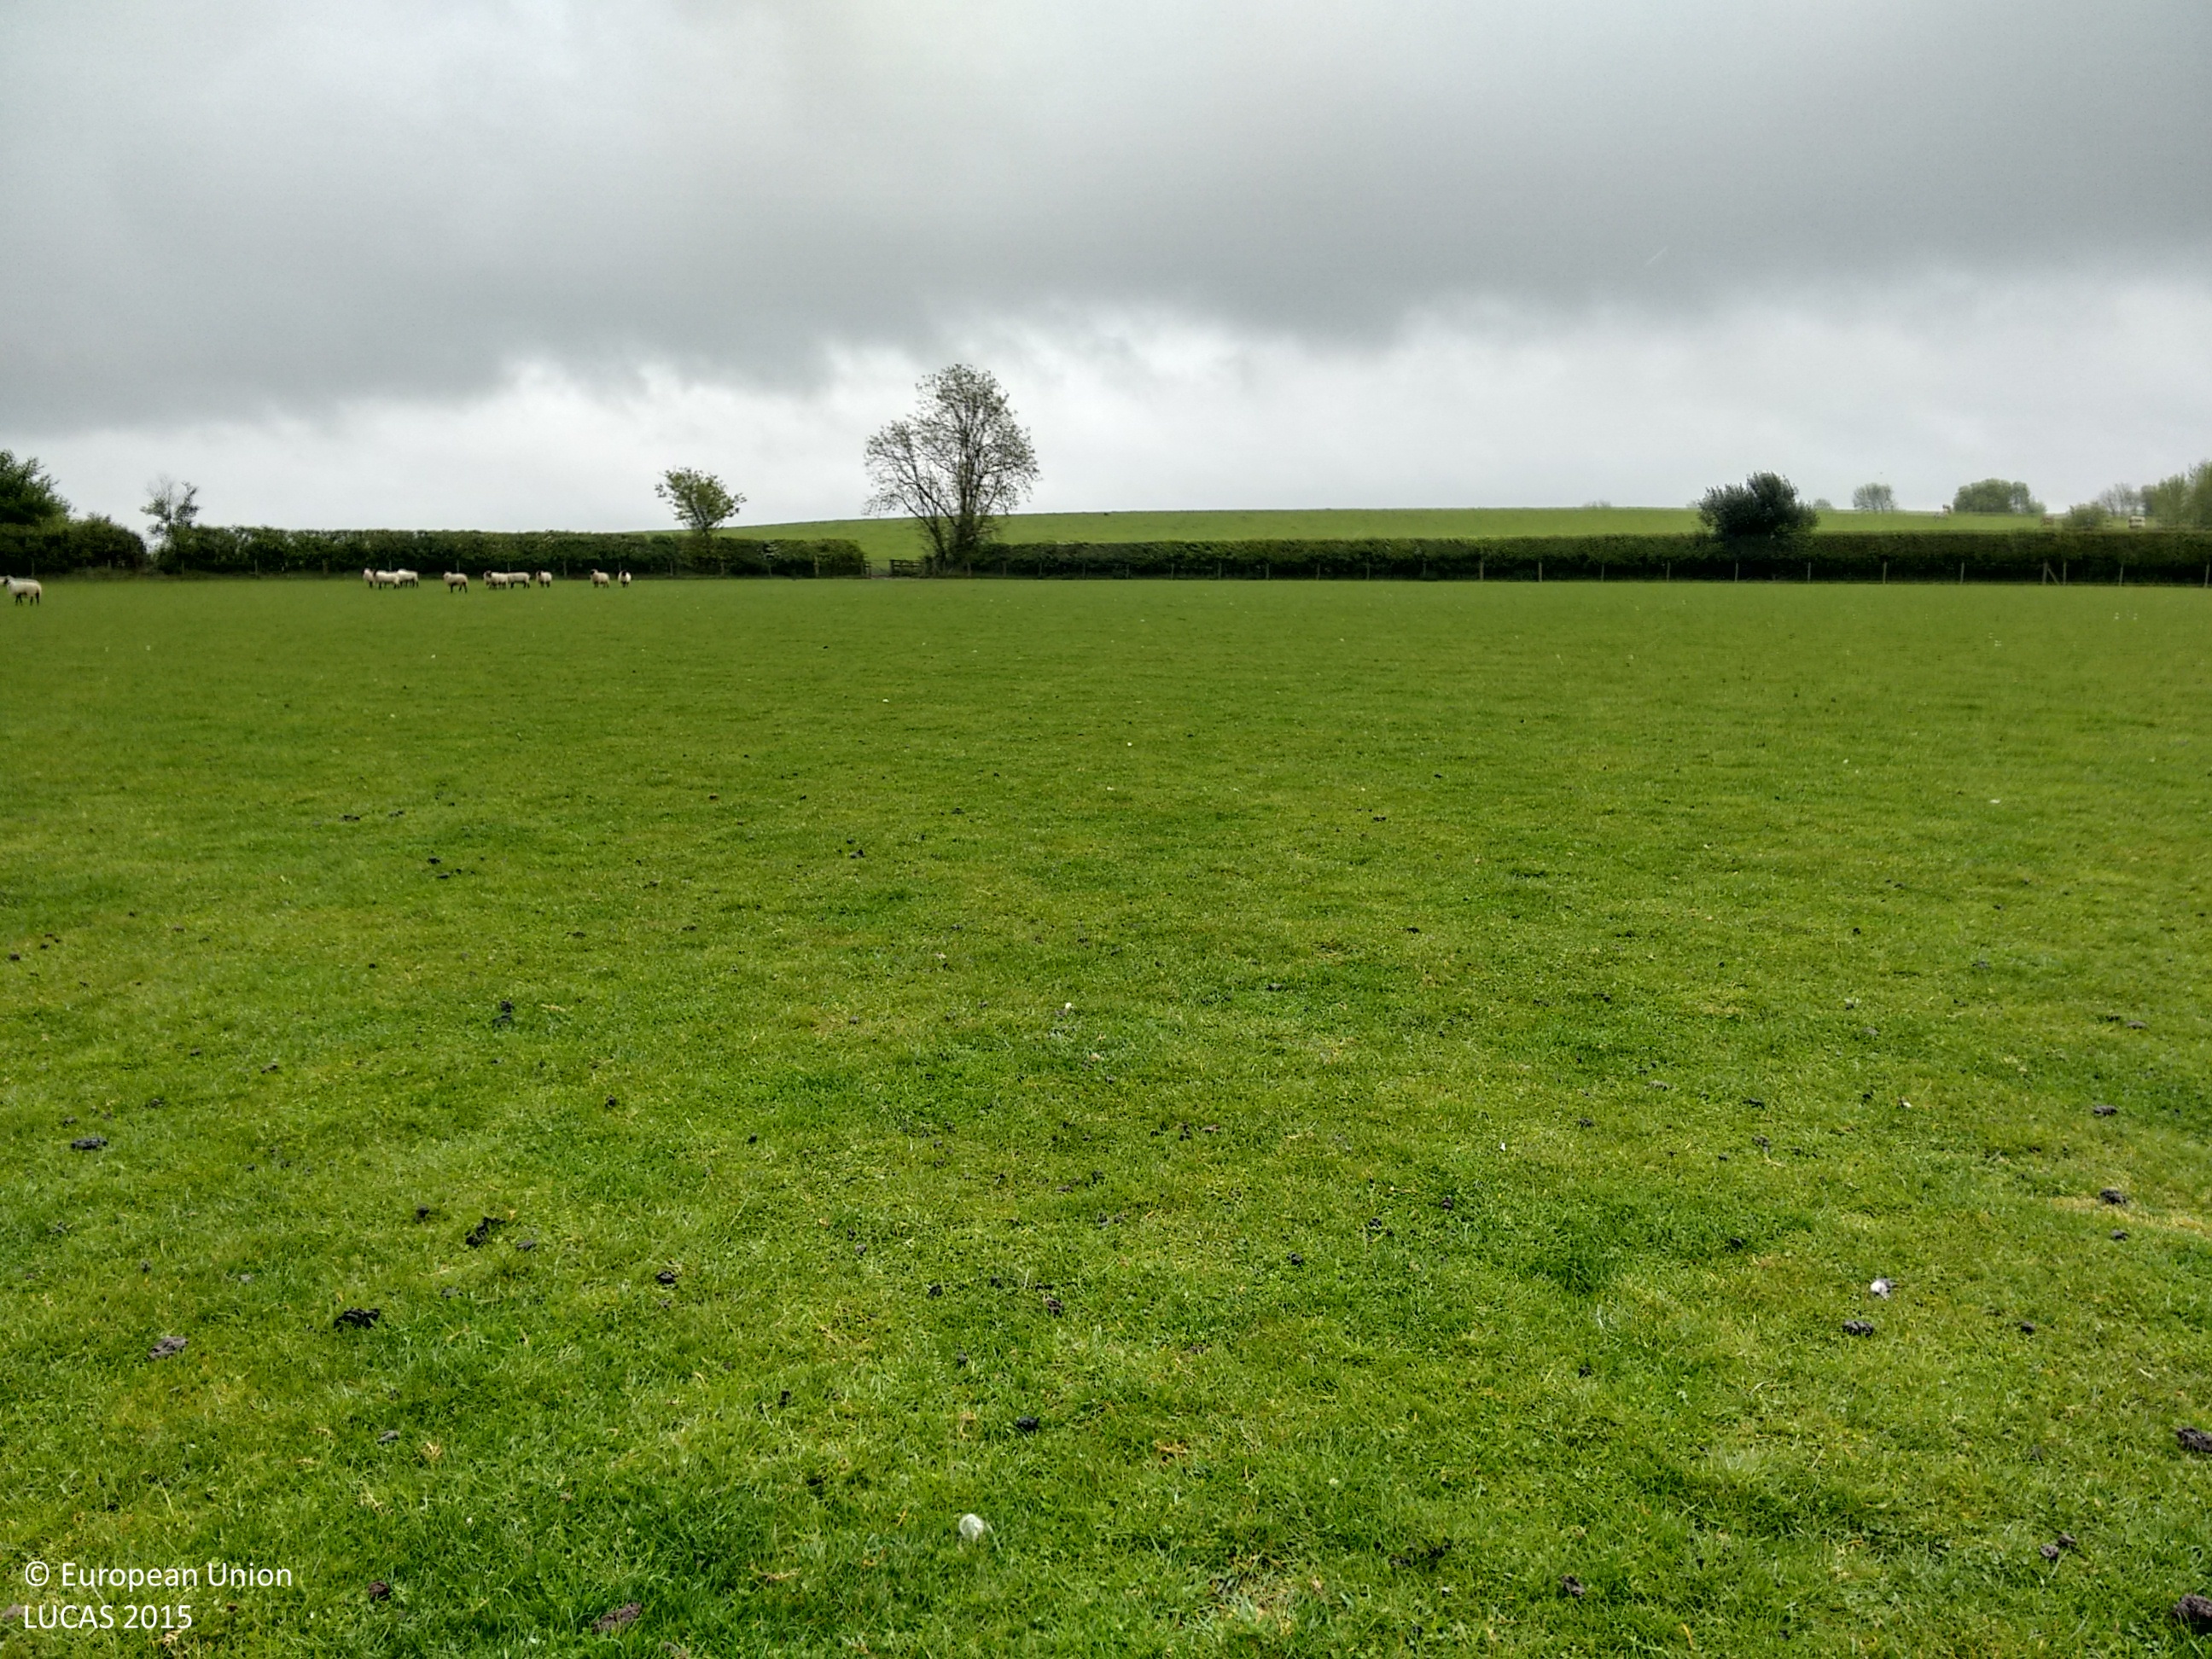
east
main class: Grassland
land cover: Grassland without tree/shrub cover
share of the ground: > 75 %
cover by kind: herbaceous plants 100 %
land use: Agriculture (excluding fallow land and kitchen gardens)
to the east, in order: Grassland without tree/shrub cover; Fences; Managed hedges; Fences; Grassland without tree/shrub cover
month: May
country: GB
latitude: 52.3708
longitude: -1.4032
